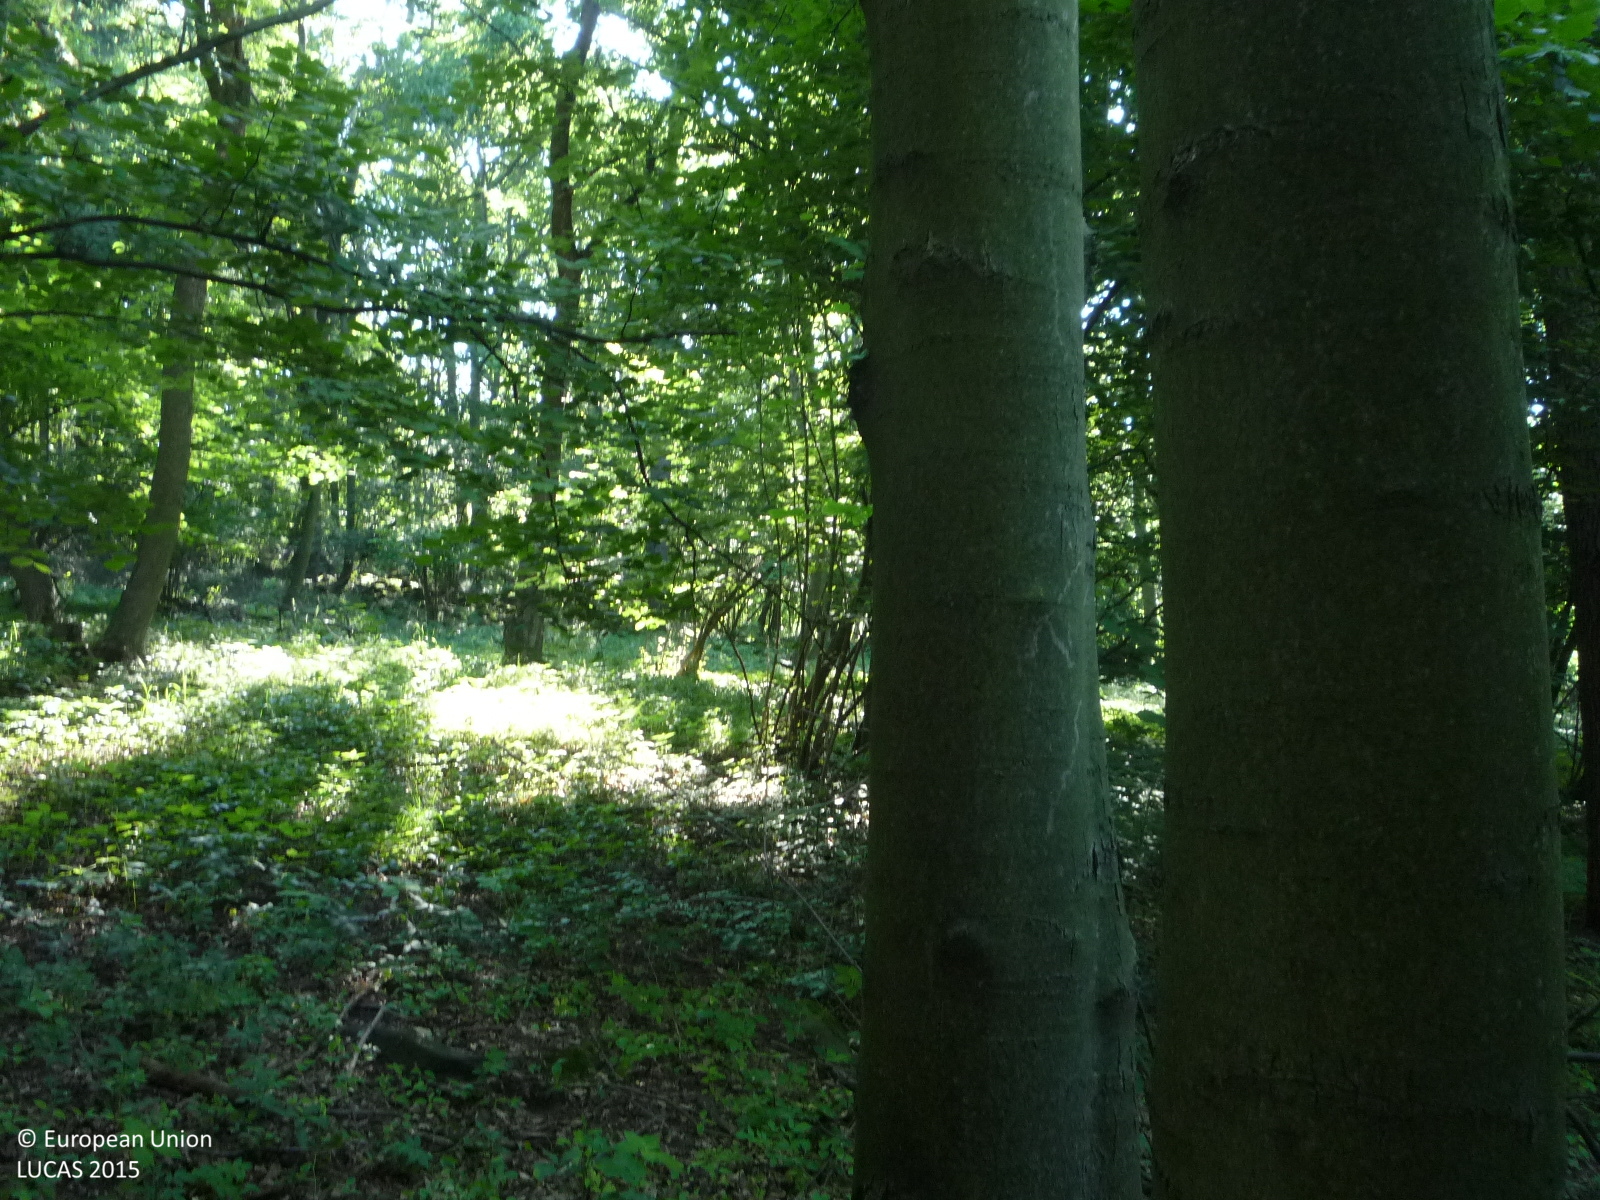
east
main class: Woodland
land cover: Broadleaved woodland
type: mesophytic deciduous forest
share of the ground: > 75 %
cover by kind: broadleaved forest trees 95 %, shrubs 5 %
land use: Forestry
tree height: > 5 m
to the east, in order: Broadleaved woodland; Grassland without tree/shrub cover; Rivers and streams; Broadleaved woodland; Tracks; Broadleaved woodland
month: July
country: CZ
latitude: 50.5323
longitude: 13.8805
